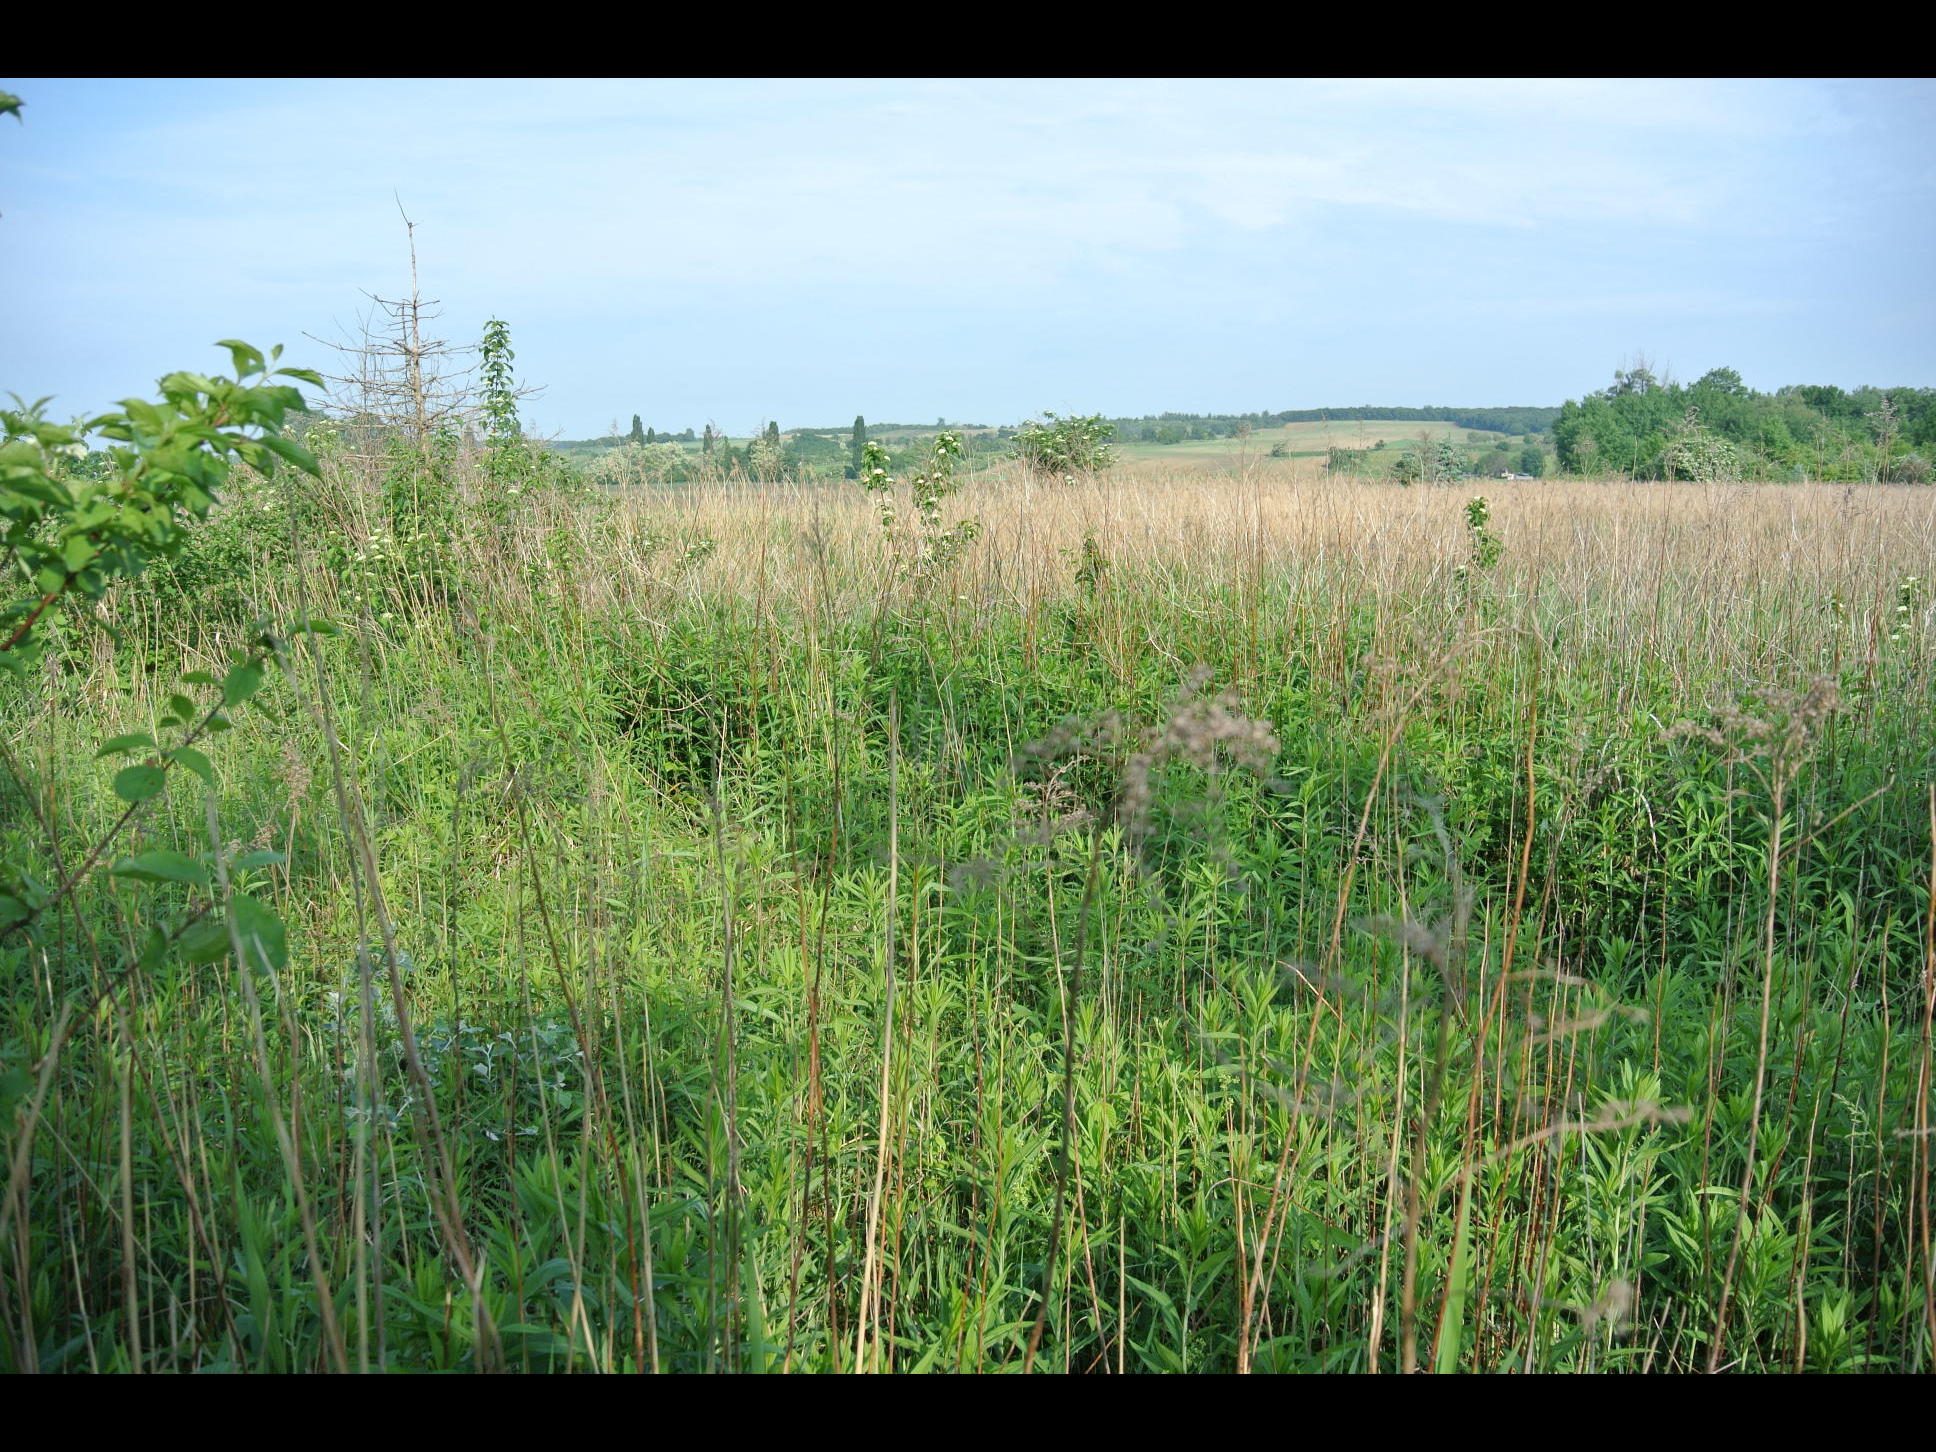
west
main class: Shrubland
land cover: Shrubland with sparse tree cover
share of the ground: 50 - 75 %
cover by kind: shrubs 65 %, herbaceous plants 30 %, broadleaved forest trees 5 %
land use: Semi-natural and natural areas not in use
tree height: > 5 m
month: May
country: AT
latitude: 48.0638
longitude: 16.5674
